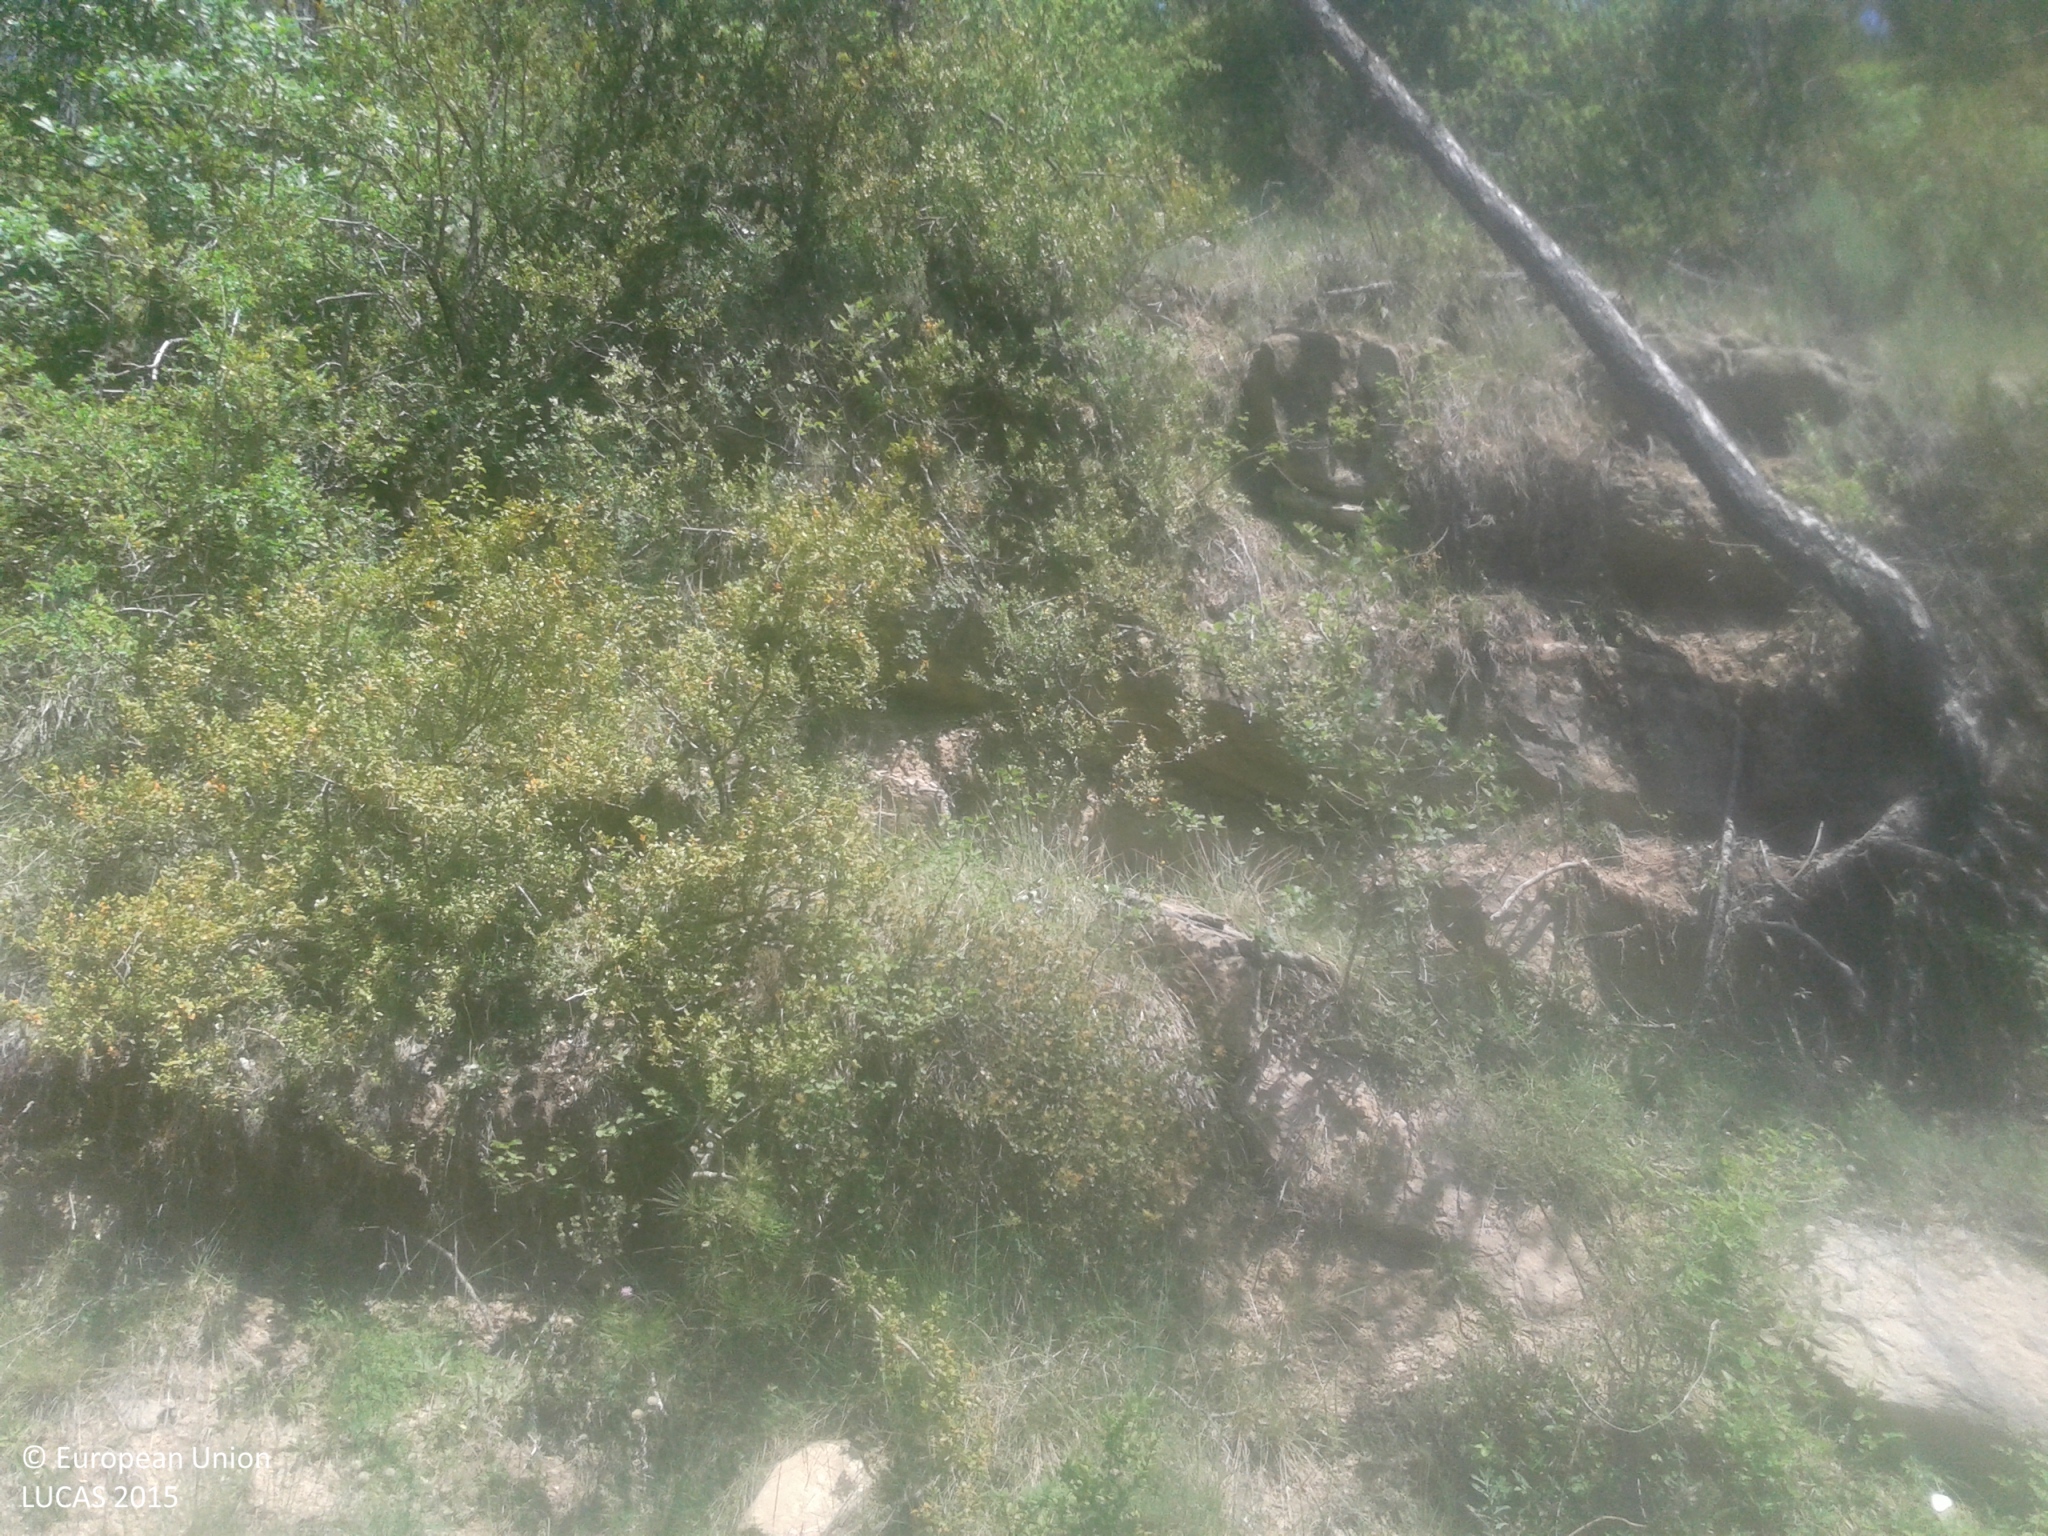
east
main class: Woodland
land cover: Pine dominated mixed woodland
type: coniferous forest of the mediterranean region
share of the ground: > 75 %
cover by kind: coniferous forest trees 55 %, broadleaved forest trees 20 %, shrubs 20 %, herbaceous plants 5 %
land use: Forestry
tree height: > 5 m
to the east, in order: Pine dominated mixed woodland; Tracks; Pine dominated mixed woodland; Tracks; Pine dominated mixed woodland
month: May
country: ES
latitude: 42.0338
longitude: 1.6176
